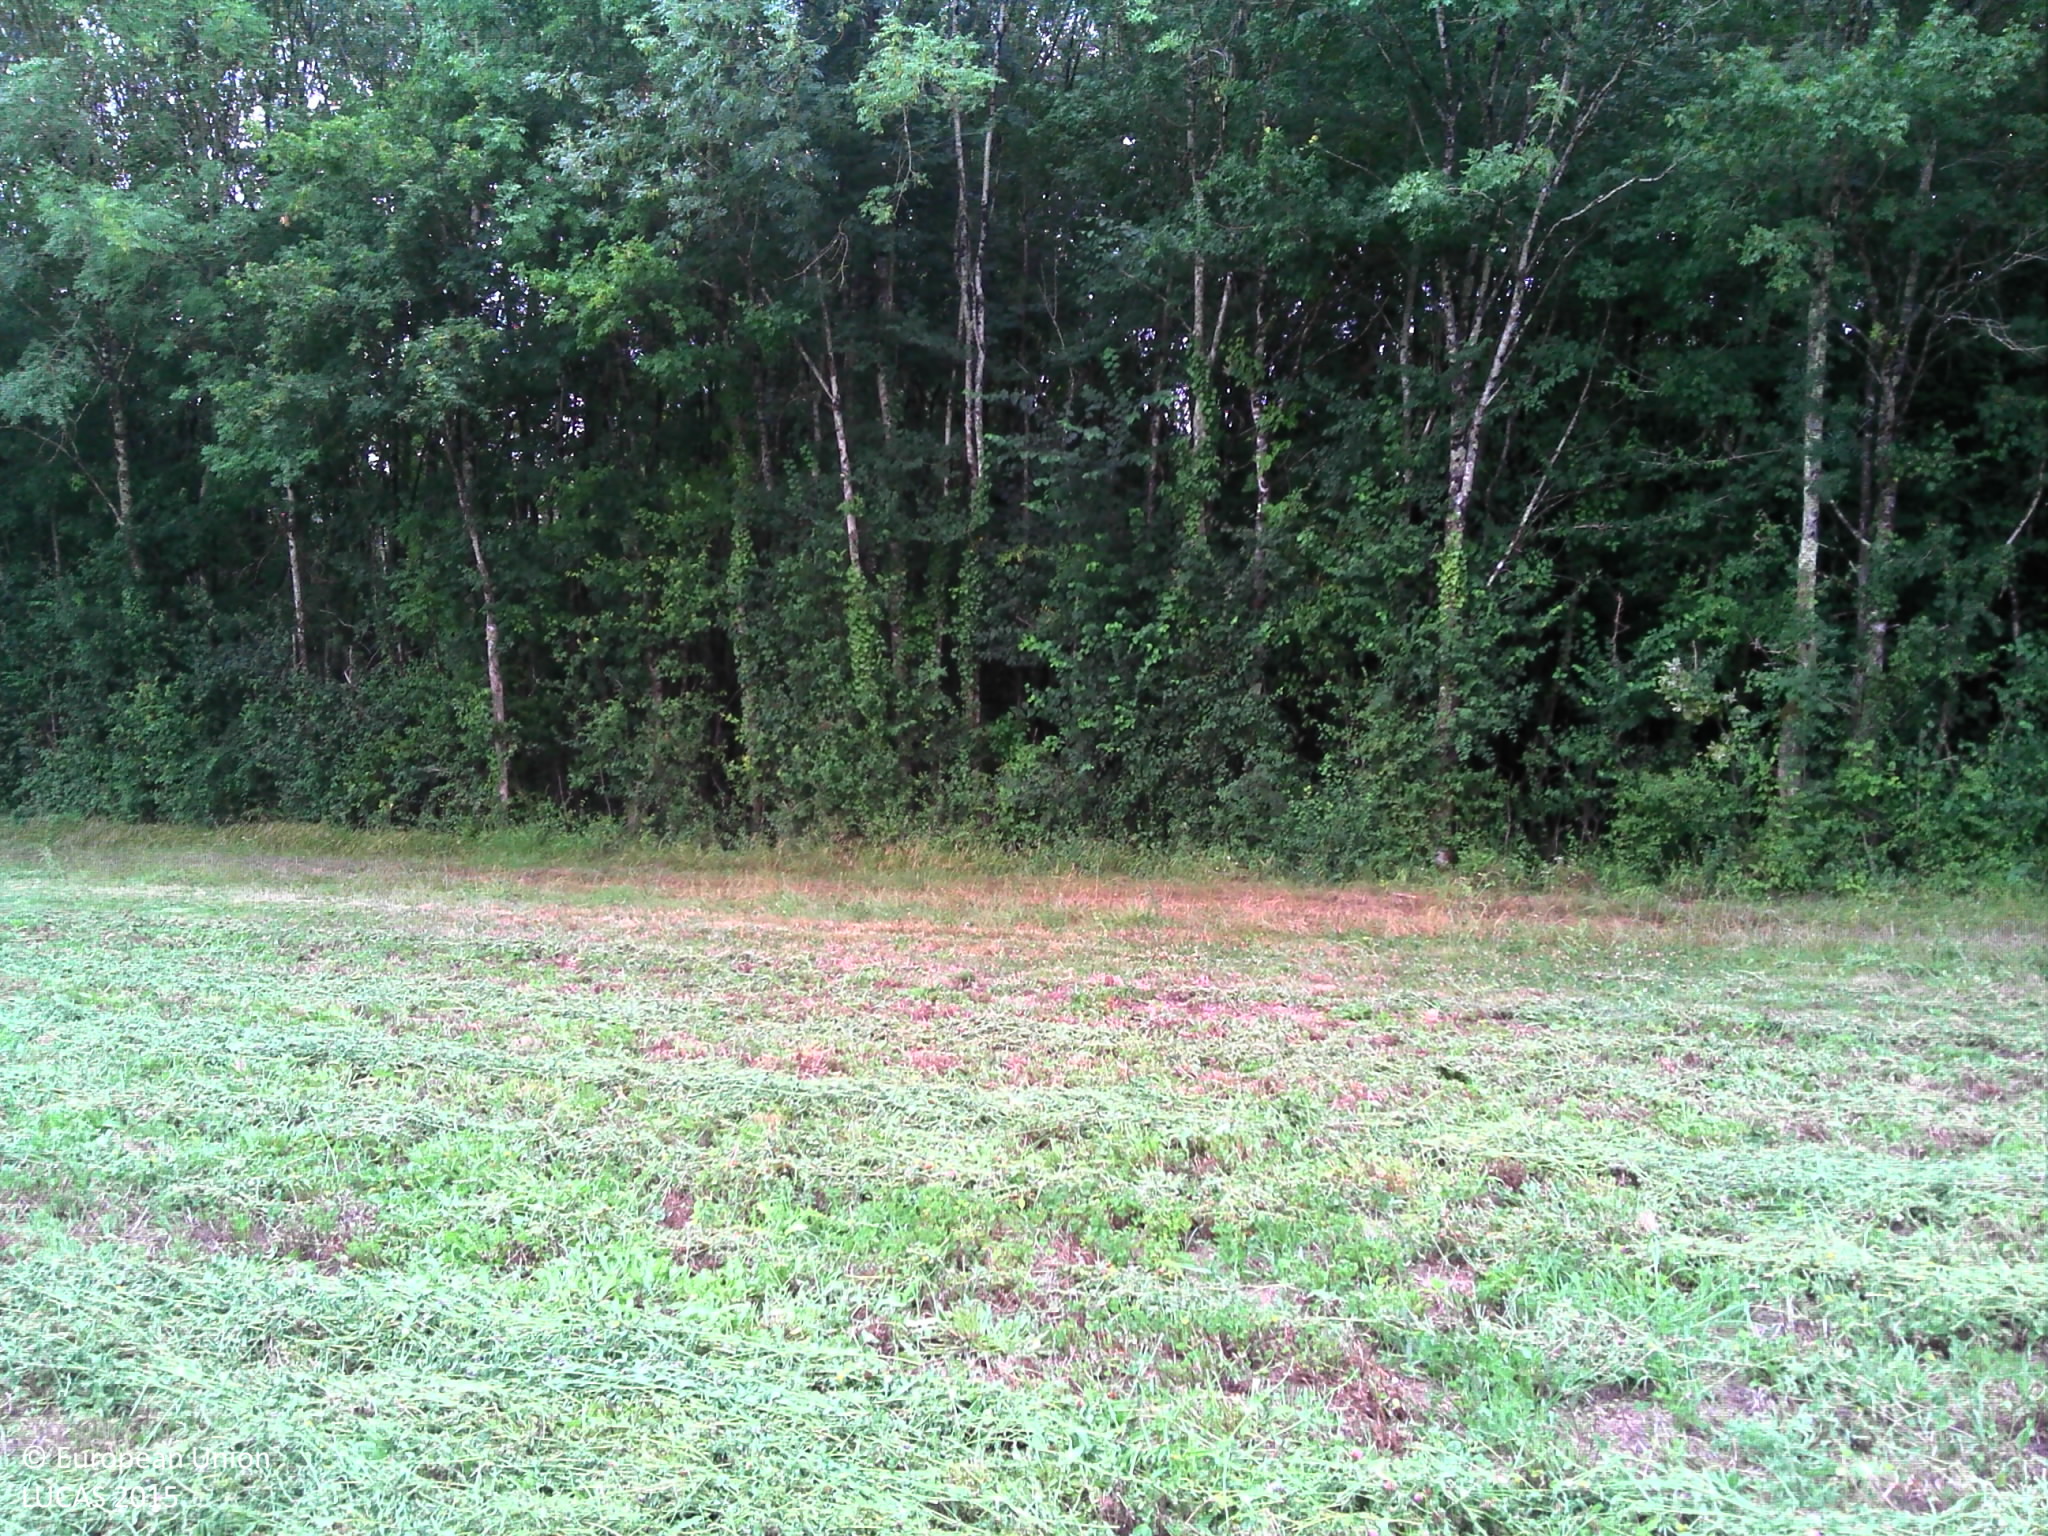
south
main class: Cropland
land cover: Lucerne
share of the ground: > 75 %
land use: Agriculture (excluding fallow land and kitchen gardens)
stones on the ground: < 10 %
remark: Harvested field
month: July
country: FR
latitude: 44.6644
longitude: 0.7734
